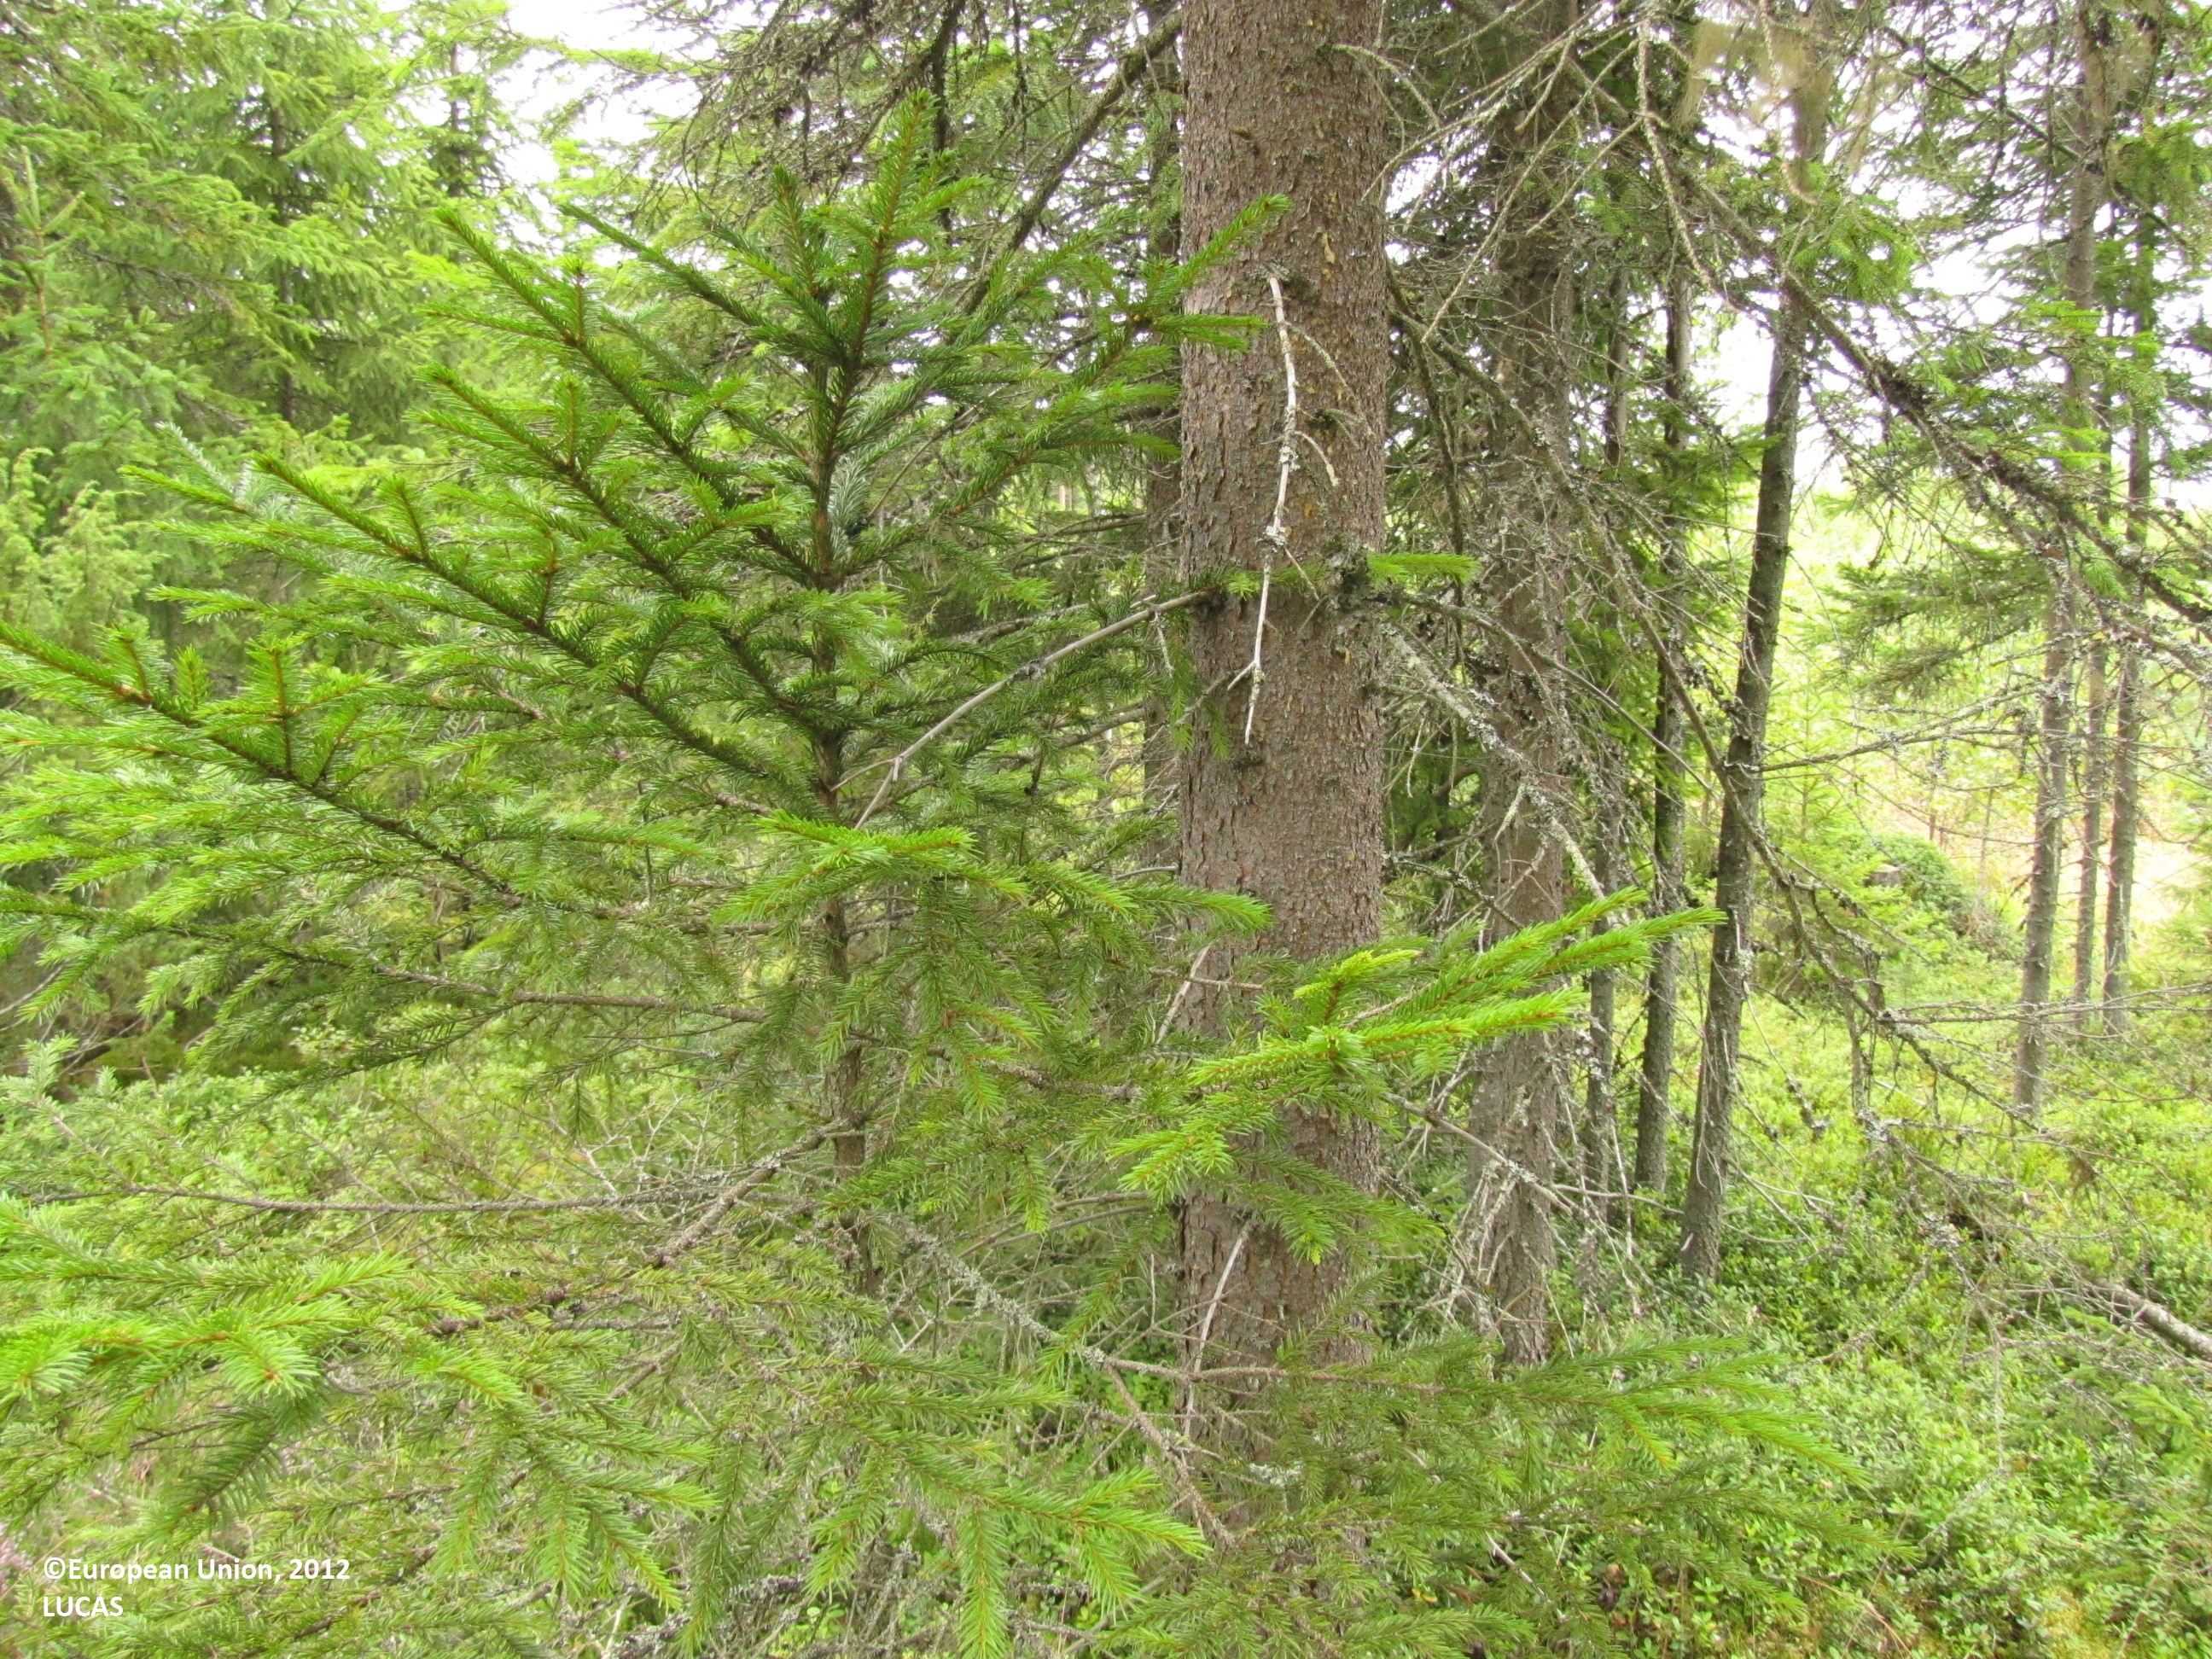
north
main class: Woodland
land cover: Spruce dominated coniferous woodland
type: boreal forest
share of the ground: 50 - 75 %
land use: Forestry
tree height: > 5 m
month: August
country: FI
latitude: 61.9321
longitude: 23.0424
